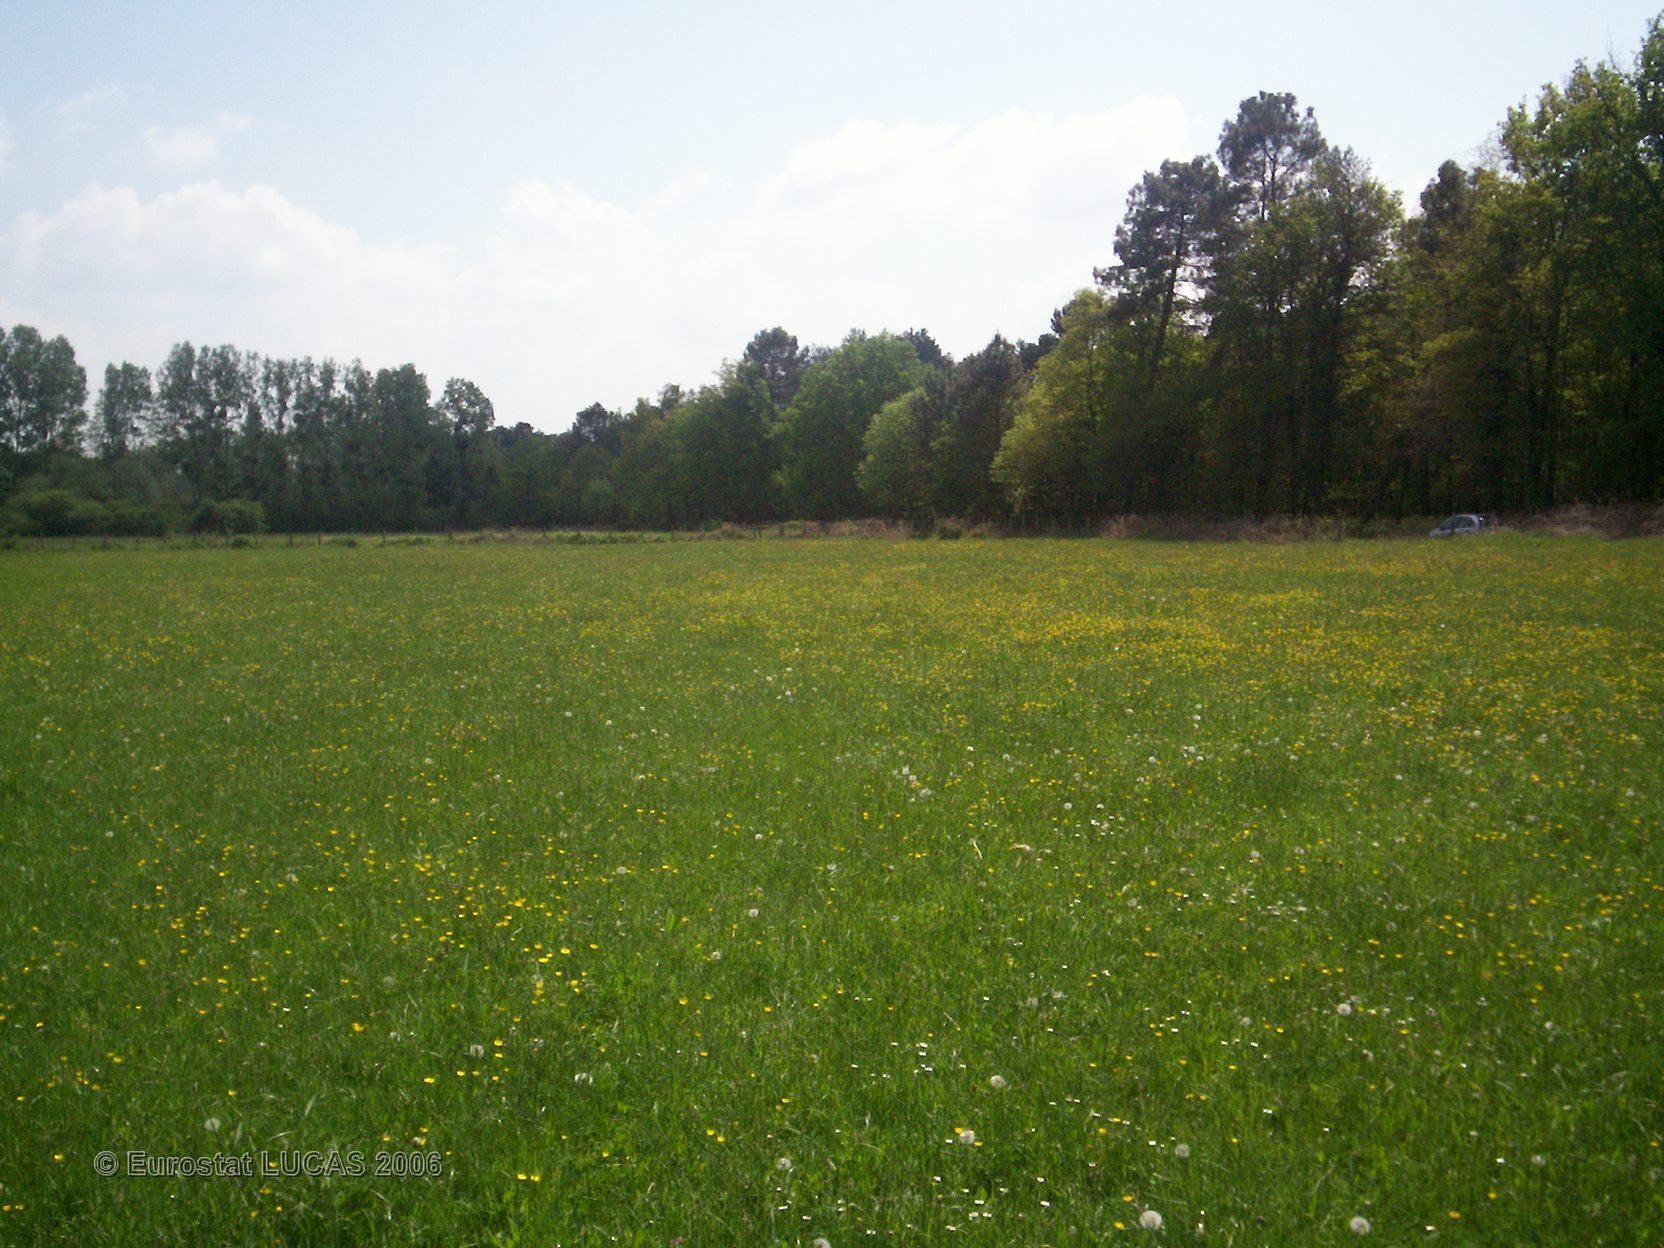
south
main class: Grassland
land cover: Grassland without tree/shrub cover
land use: Agriculture (excluding fallow land and kitchen gardens)
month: May
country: FR
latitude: 47.7114
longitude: 0.1783
